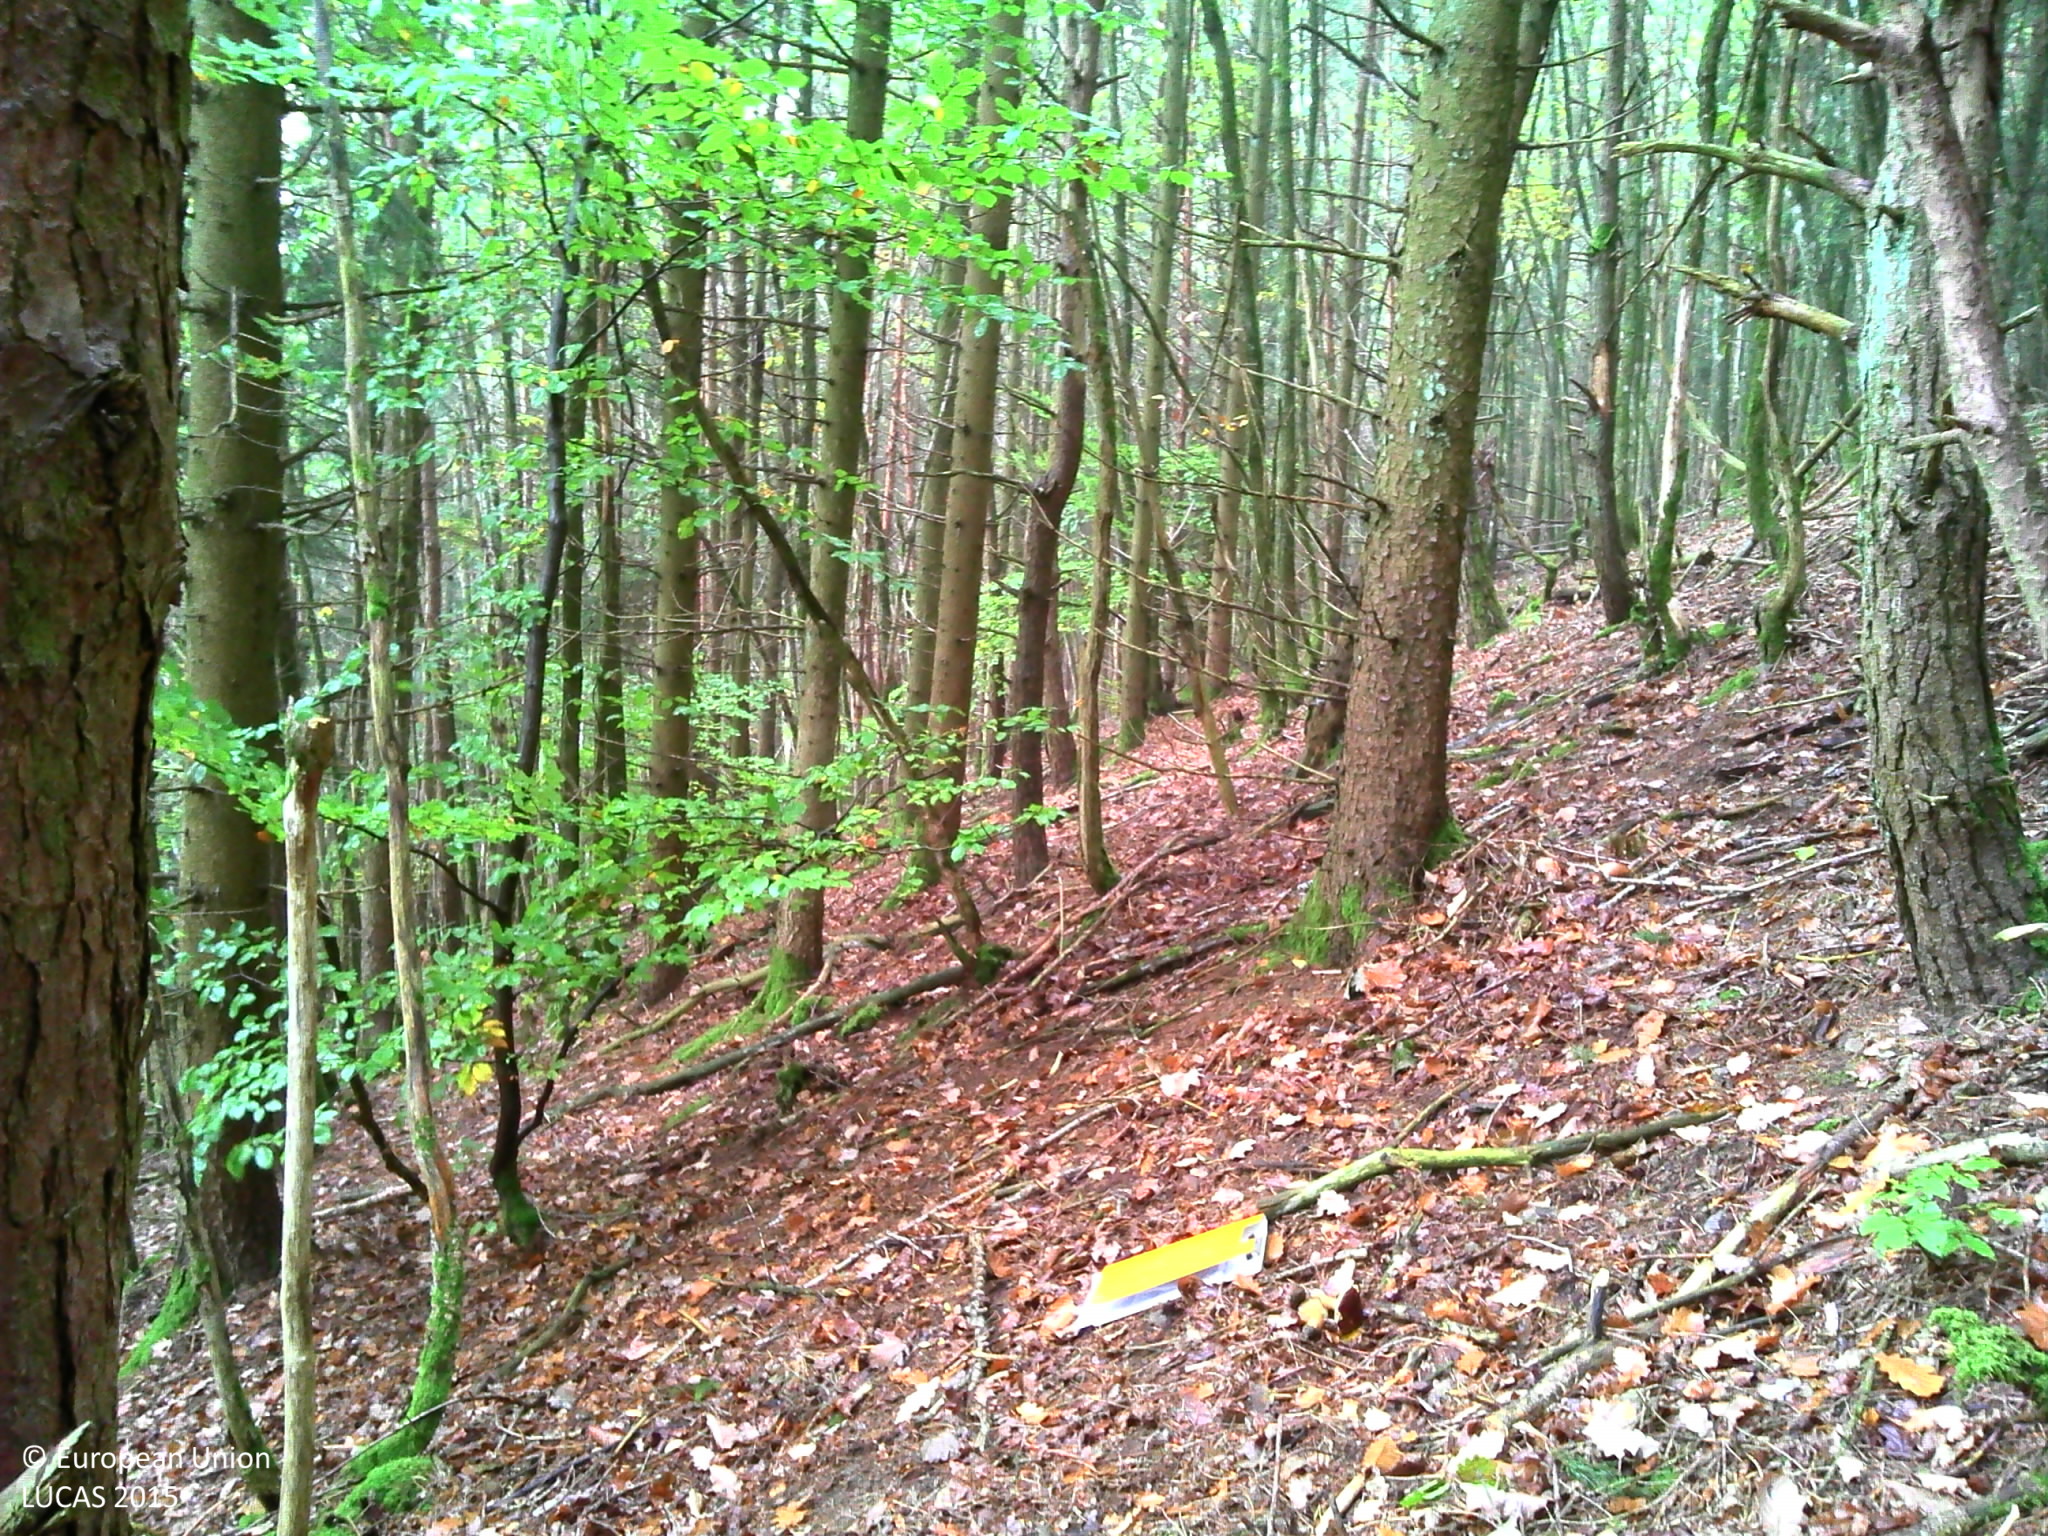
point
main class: Woodland
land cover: Spruce dominated mixed woodland
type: hemiboreal forest and nemoral coniferous forest and mixed broadleaved-coniferous forest
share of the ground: > 75 %
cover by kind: coniferous forest trees 60 %, broadleaved forest trees 25 %, herbaceous plants 15 %
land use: Forestry
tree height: > 5 m
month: October
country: FR
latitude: 46.1437
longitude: 2.7865
